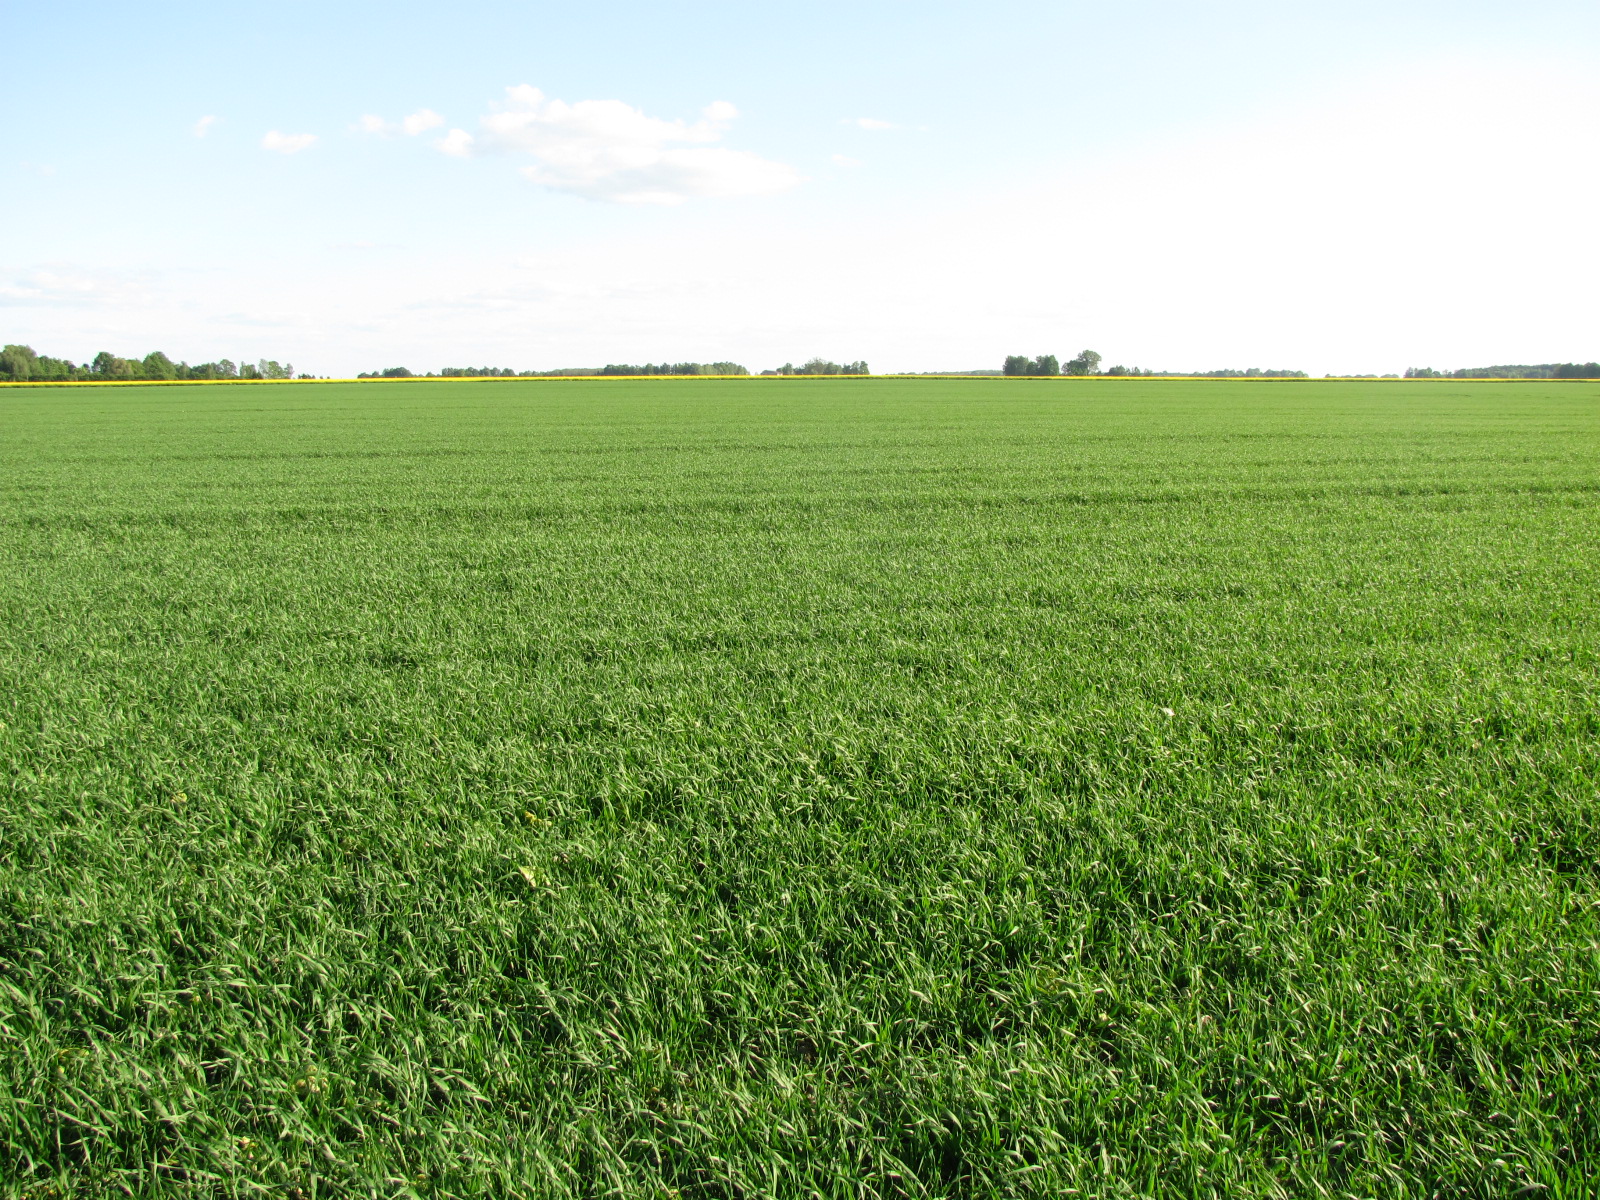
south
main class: Cropland
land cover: Common wheat
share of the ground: > 75 %
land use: Agriculture (excluding fallow land and kitchen gardens)
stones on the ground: < 10 %
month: May
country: LV
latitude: 56.5529
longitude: 23.9607
